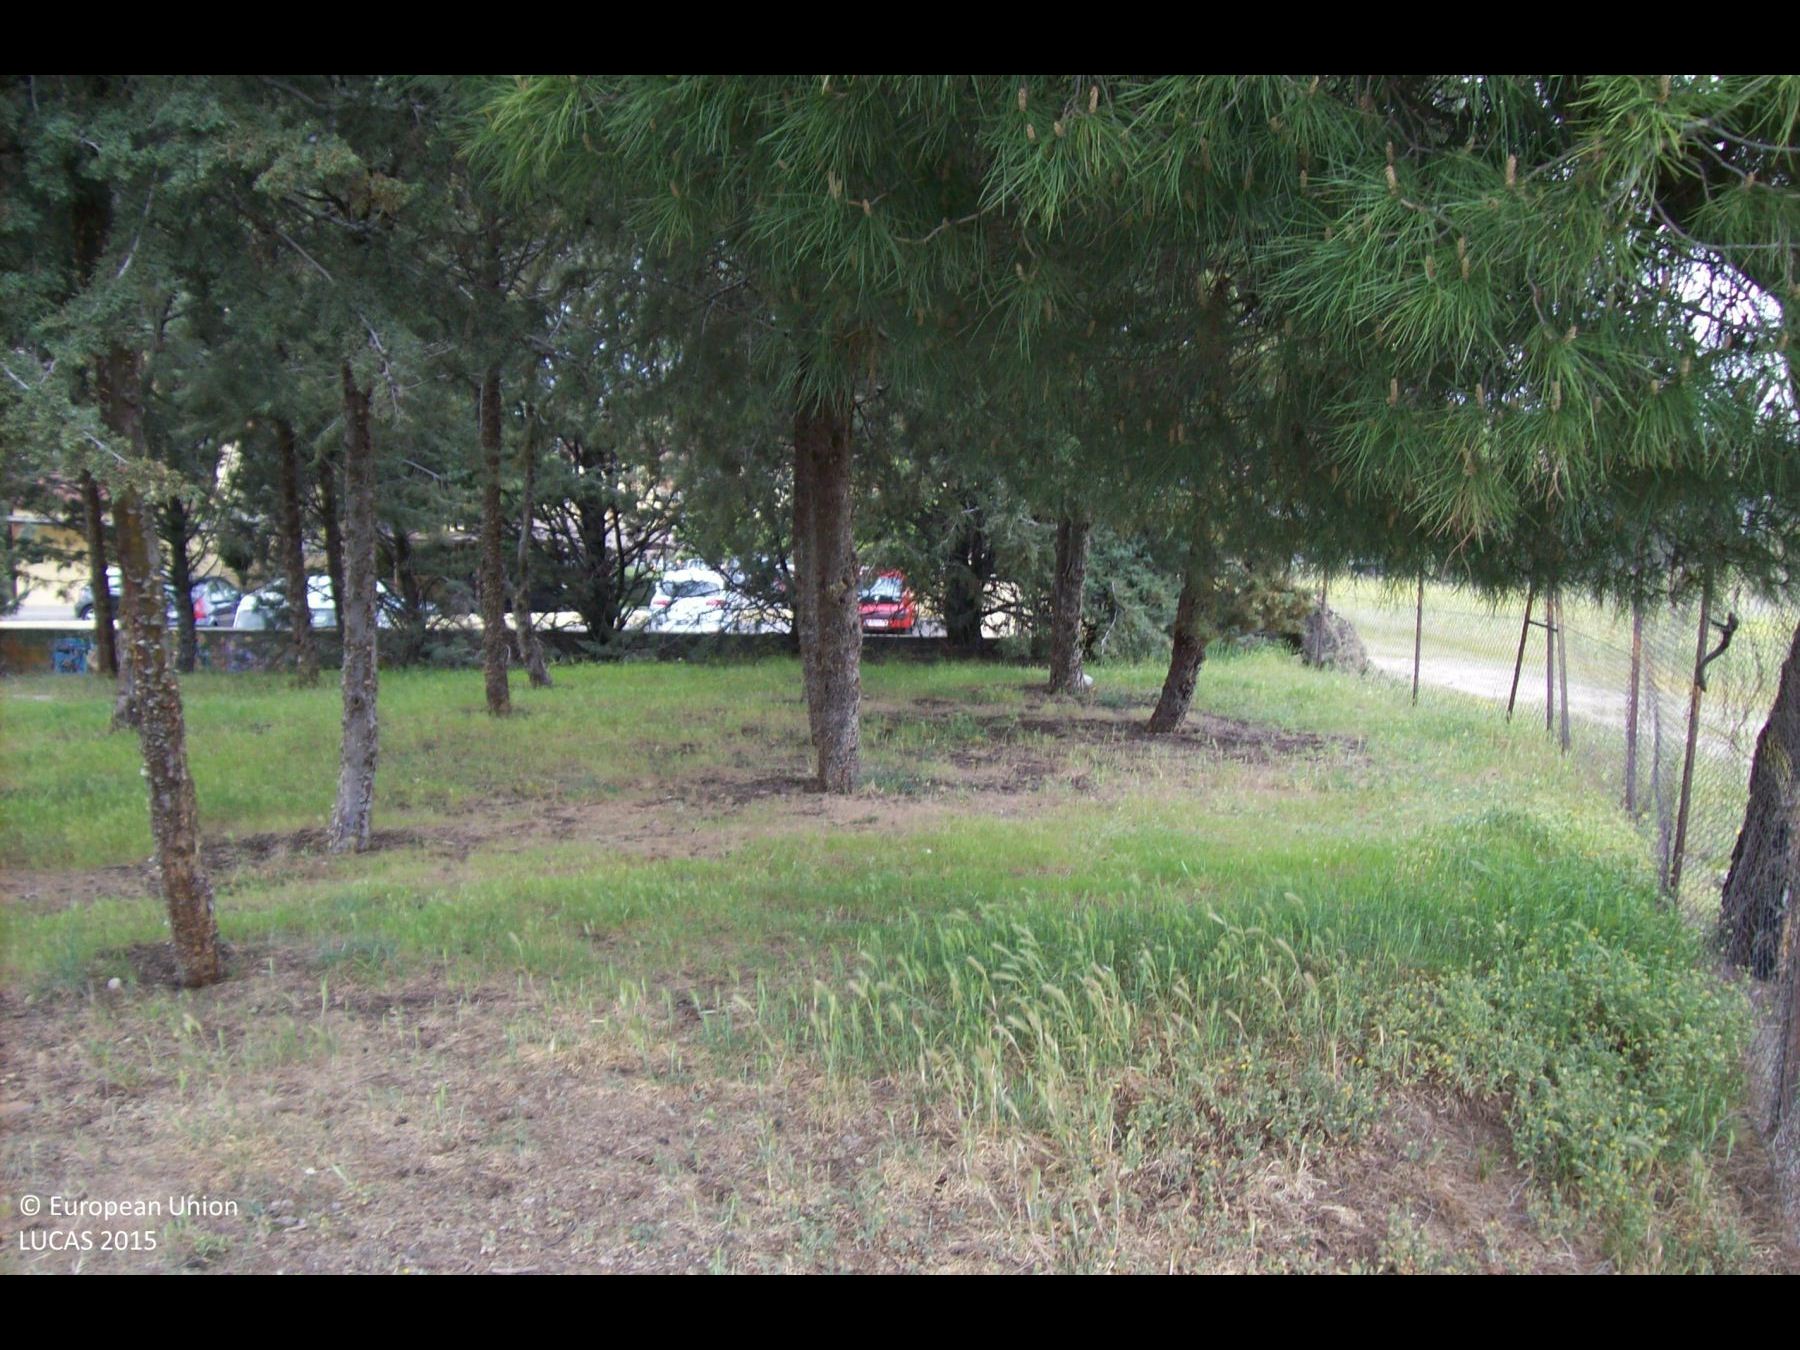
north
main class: Grassland
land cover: Grassland with sparse tree/shrub cover
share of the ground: > 75 %
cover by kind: herbaceous plants 95 %, coniferous forest trees 5 %
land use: Amenities, museums, leisure
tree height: < 5 m
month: April
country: ES
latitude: 40.4850
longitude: -3.8789
